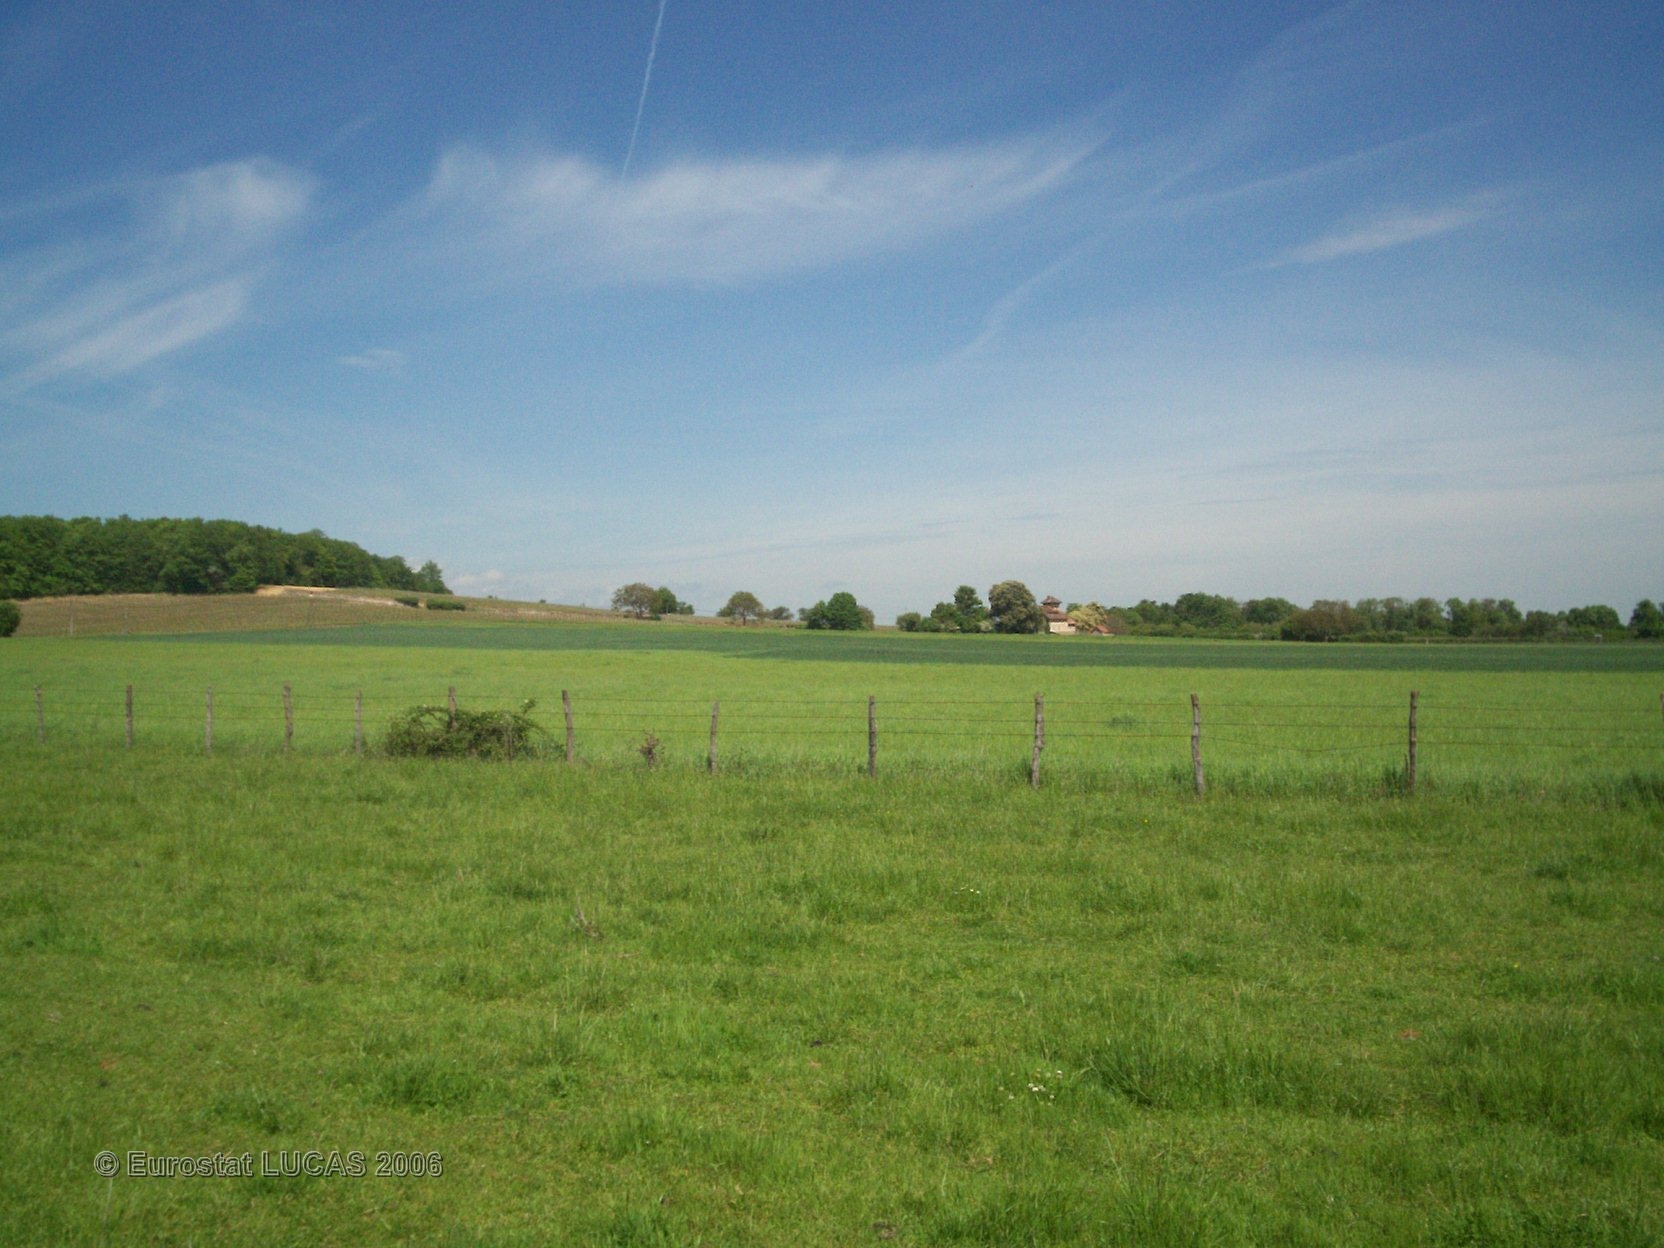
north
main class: Grassland
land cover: Grassland without tree/shrub cover
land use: Agriculture (excluding fallow land and kitchen gardens)
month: May
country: FR
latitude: 46.5829
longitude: 4.7424
